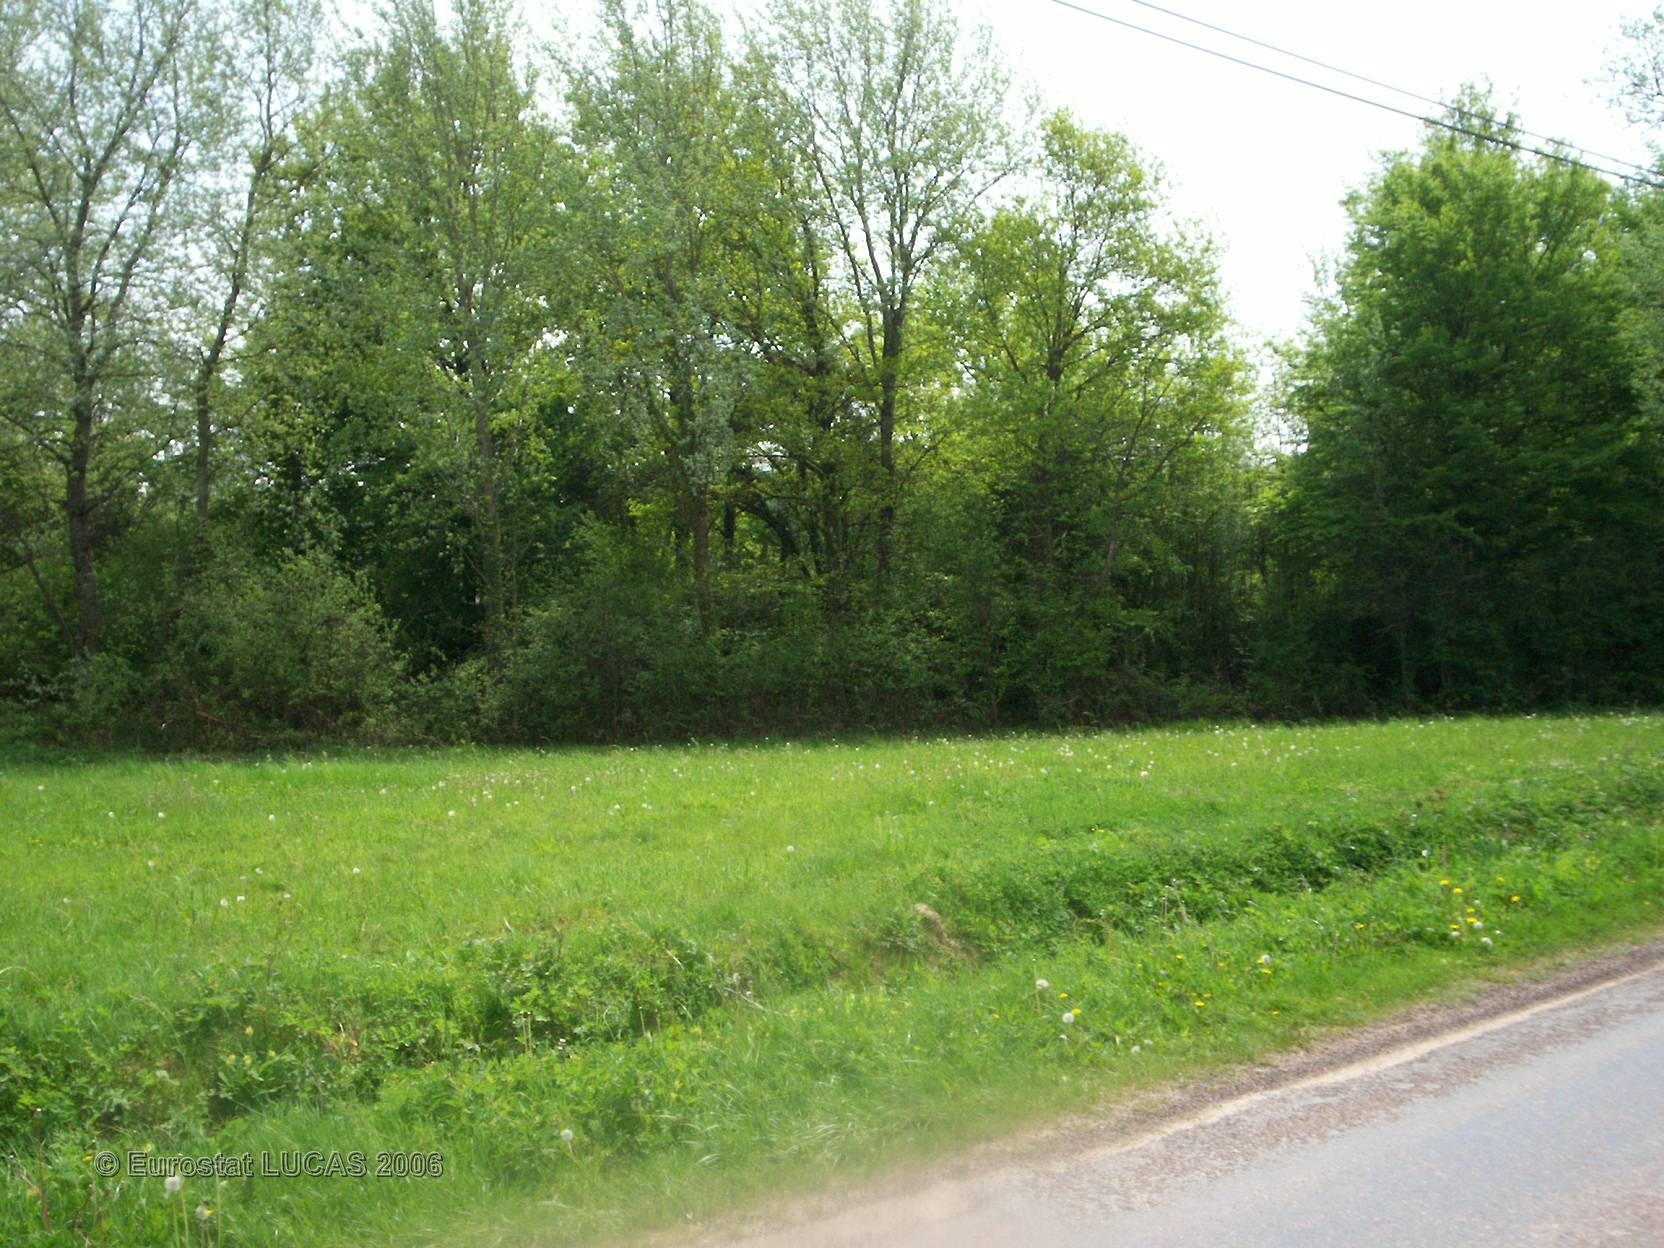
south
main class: Cropland
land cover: Sunflower
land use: Agriculture (excluding fallow land and kitchen gardens)
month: May
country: FR
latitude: 47.8890
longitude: 2.9449
